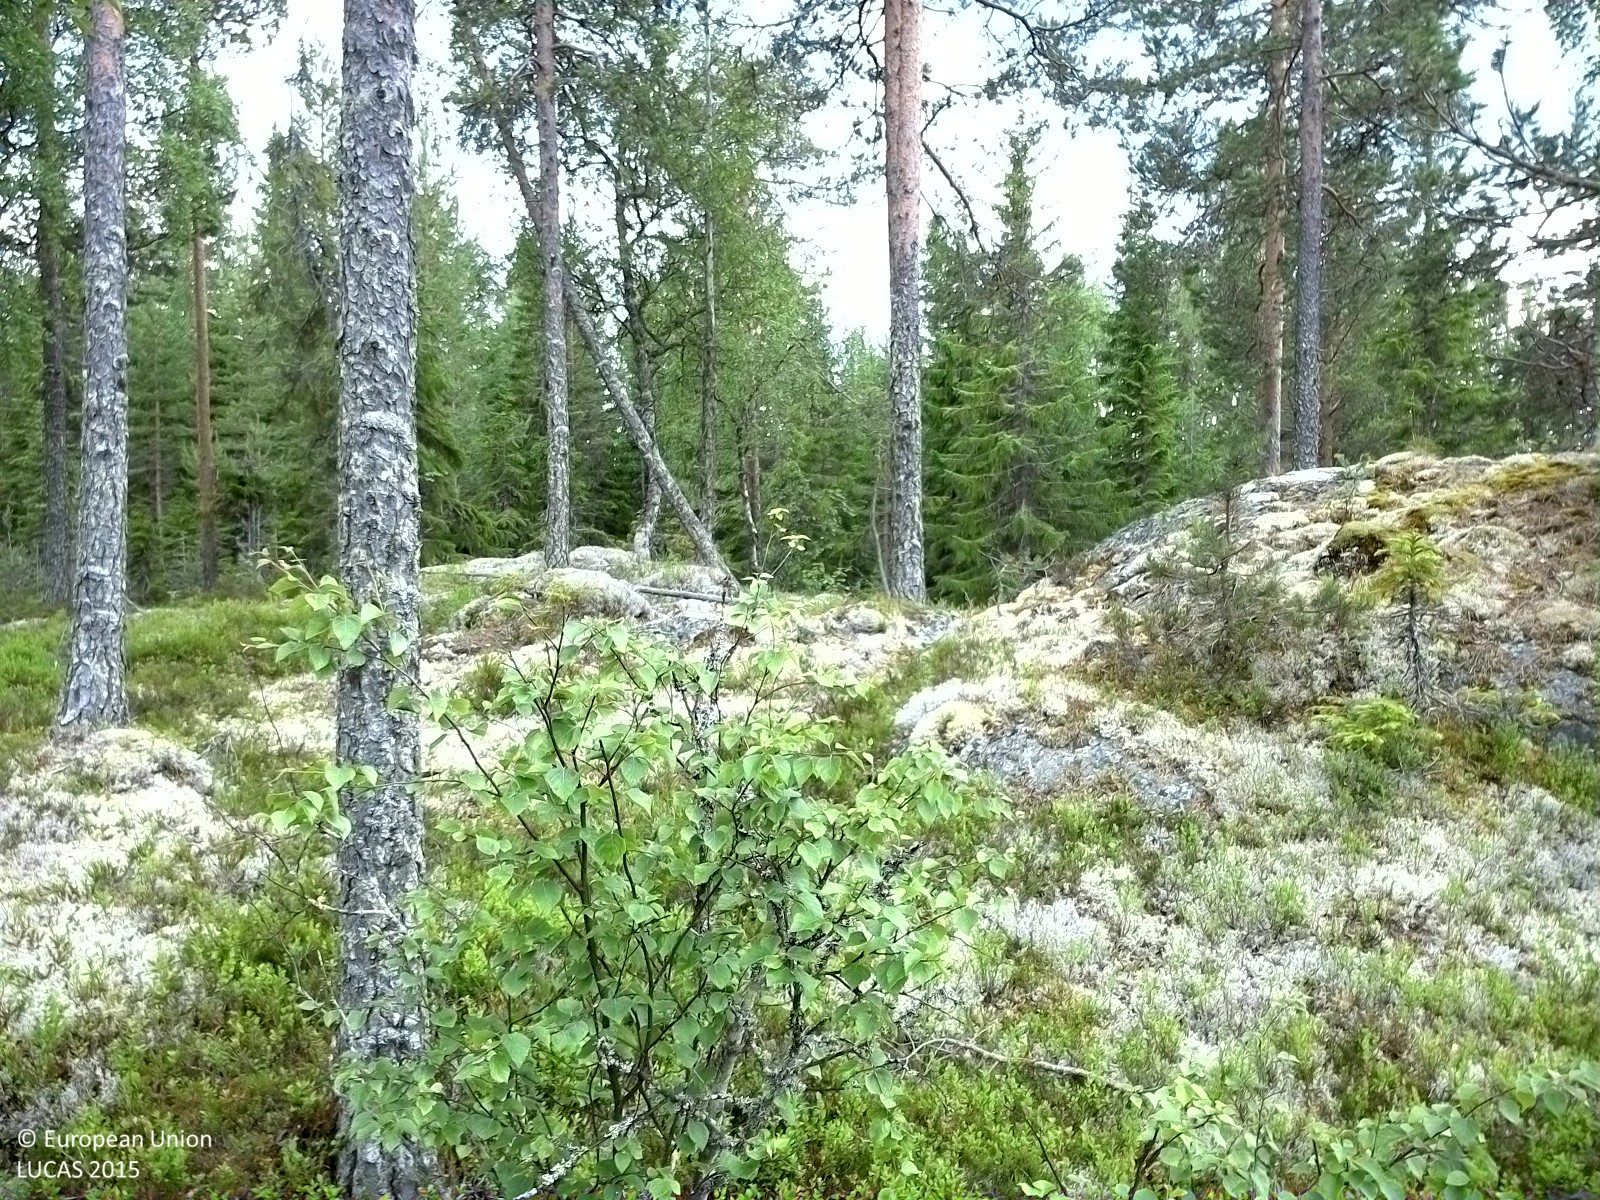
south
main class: Woodland
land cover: Pine dominated coniferous woodland
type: boreal forest
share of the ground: 10 - 25 %
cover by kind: shrubs 35 %, lichens and mosses 30 %, unconsolidated bare surface 20 %, coniferous forest trees 15 %
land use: Forestry
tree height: > 5 m
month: July
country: SE
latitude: 62.6368
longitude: 17.2532
